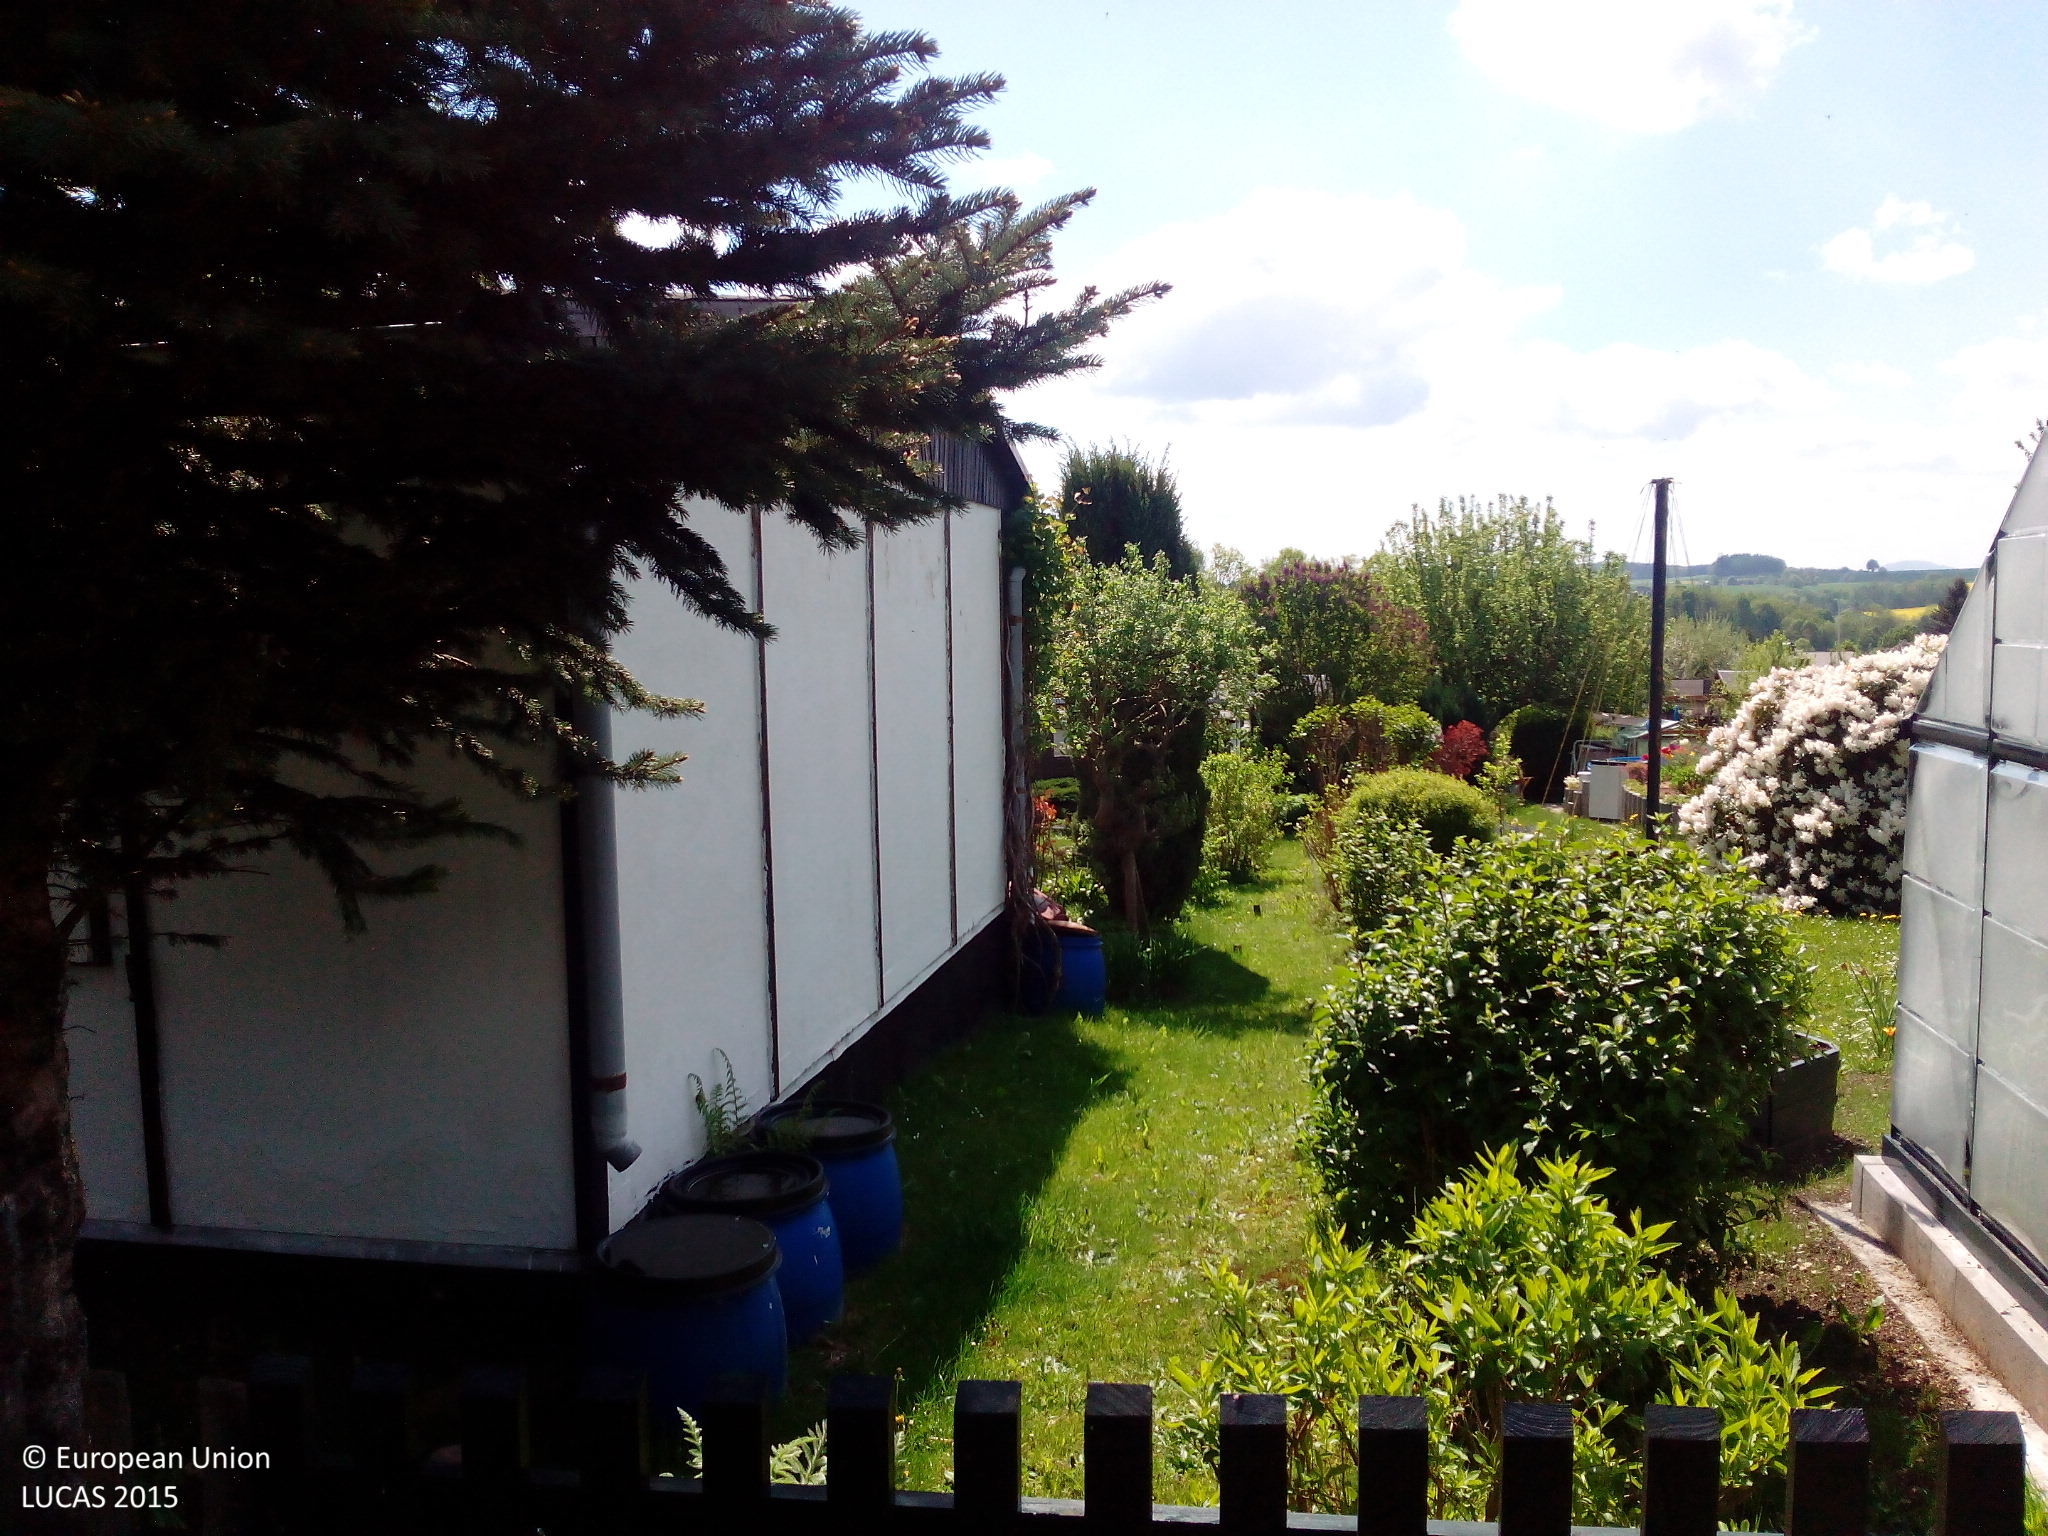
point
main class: Grassland
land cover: Grassland with sparse tree/shrub cover
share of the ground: > 75 %
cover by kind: herbaceous plants 55 %, consolidated bare surface 30 %, shrubs 10 %, broadleaved forest trees 5 %
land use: Residential
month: May
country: DE
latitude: 50.7568
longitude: 12.9910
